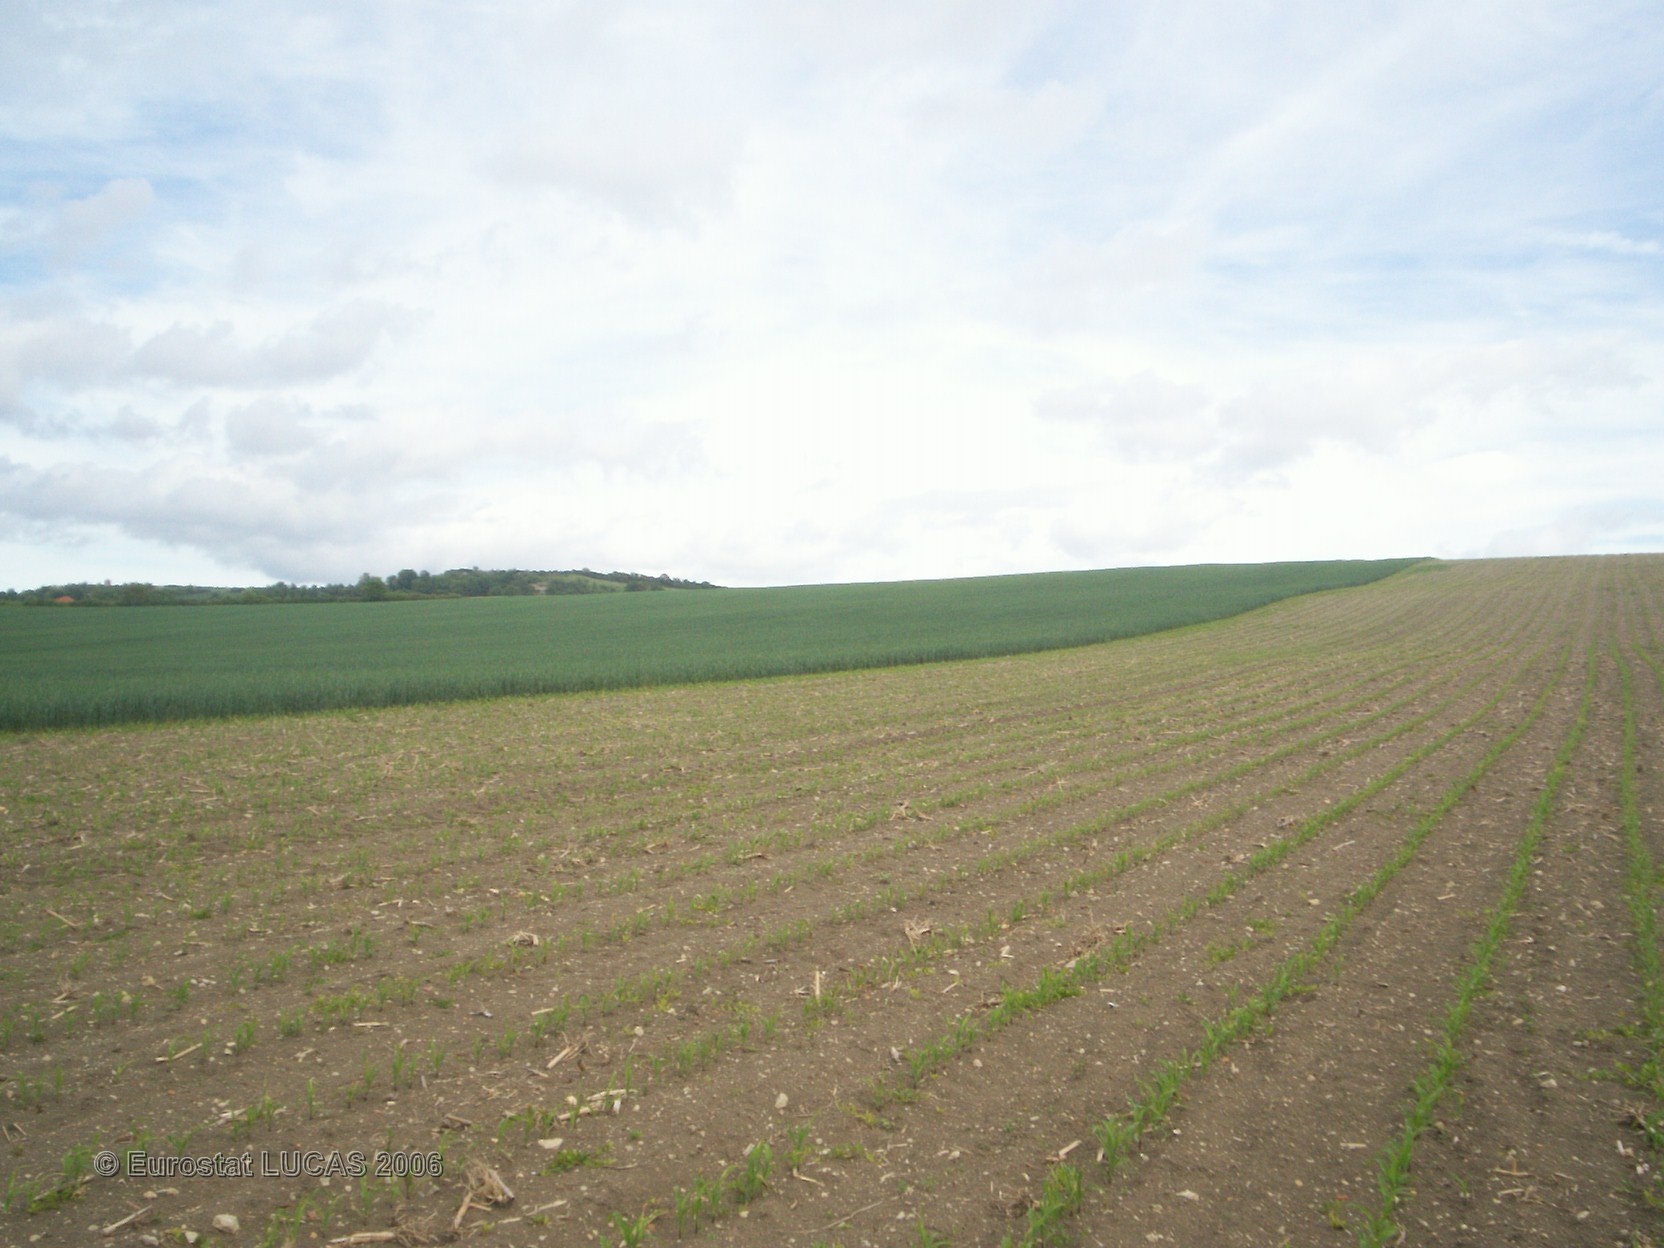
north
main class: Cropland
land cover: Maize
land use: Agriculture (excluding fallow land and kitchen gardens)
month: May
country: FR
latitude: 46.1838
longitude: 3.1192
